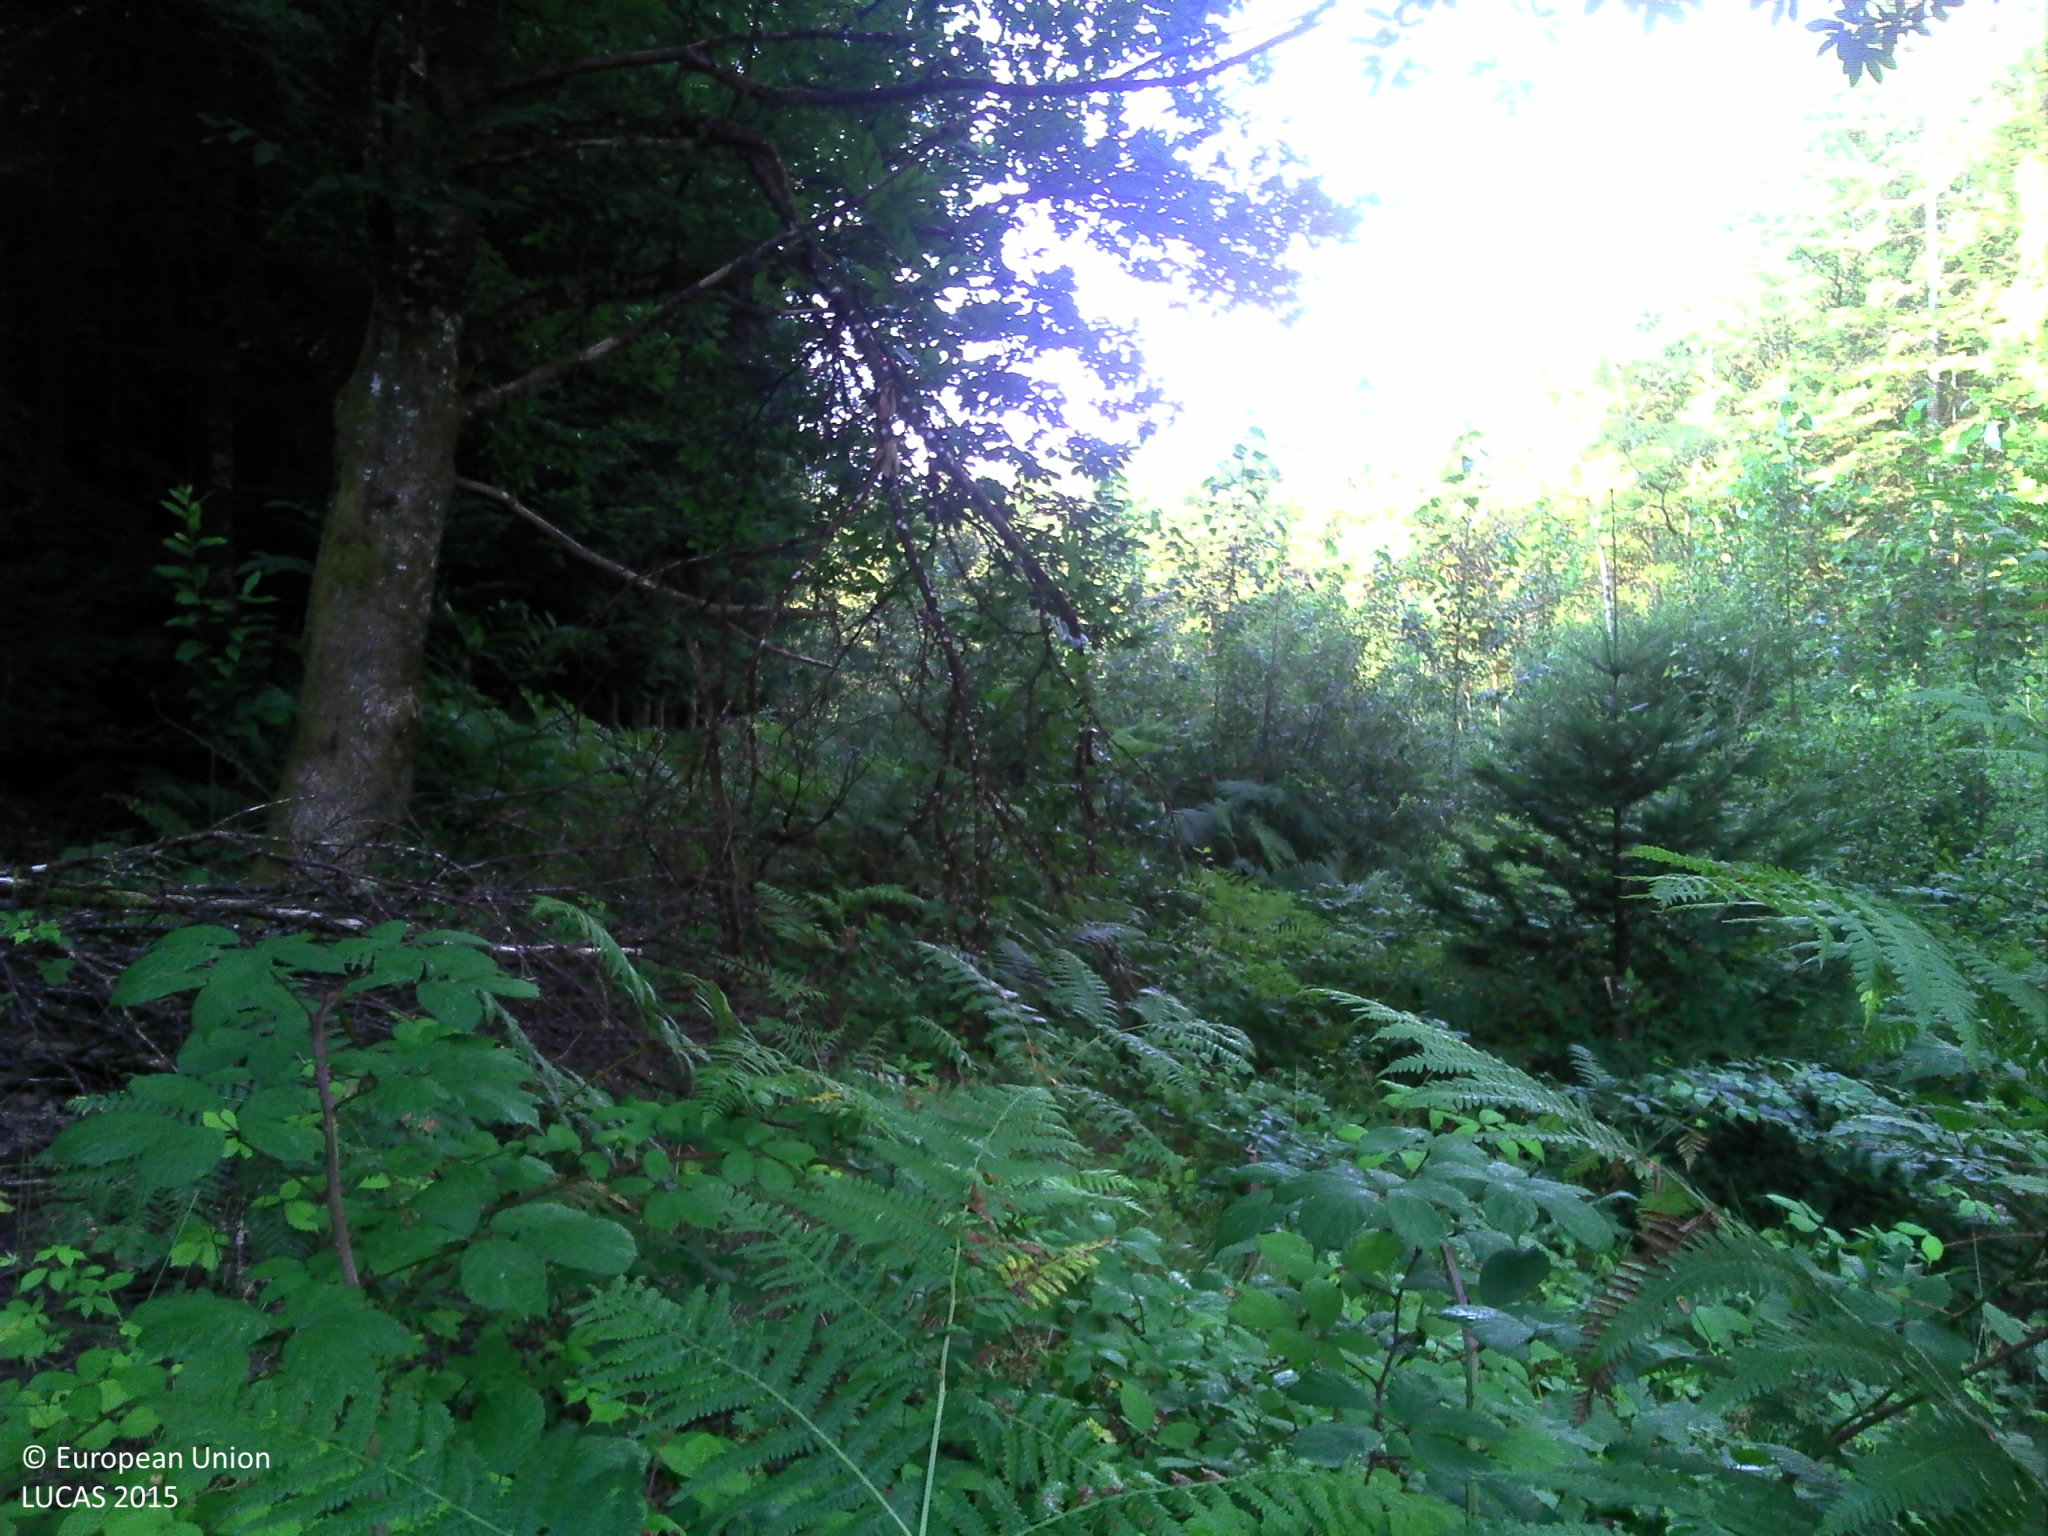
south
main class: Woodland
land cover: Spruce dominated coniferous woodland
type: exotic forest
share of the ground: > 75 %
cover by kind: coniferous forest trees 70 %, herbaceous plants 30 %
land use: Forestry
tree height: > 5 m
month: August
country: FR
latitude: 45.3730
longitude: 1.8879
